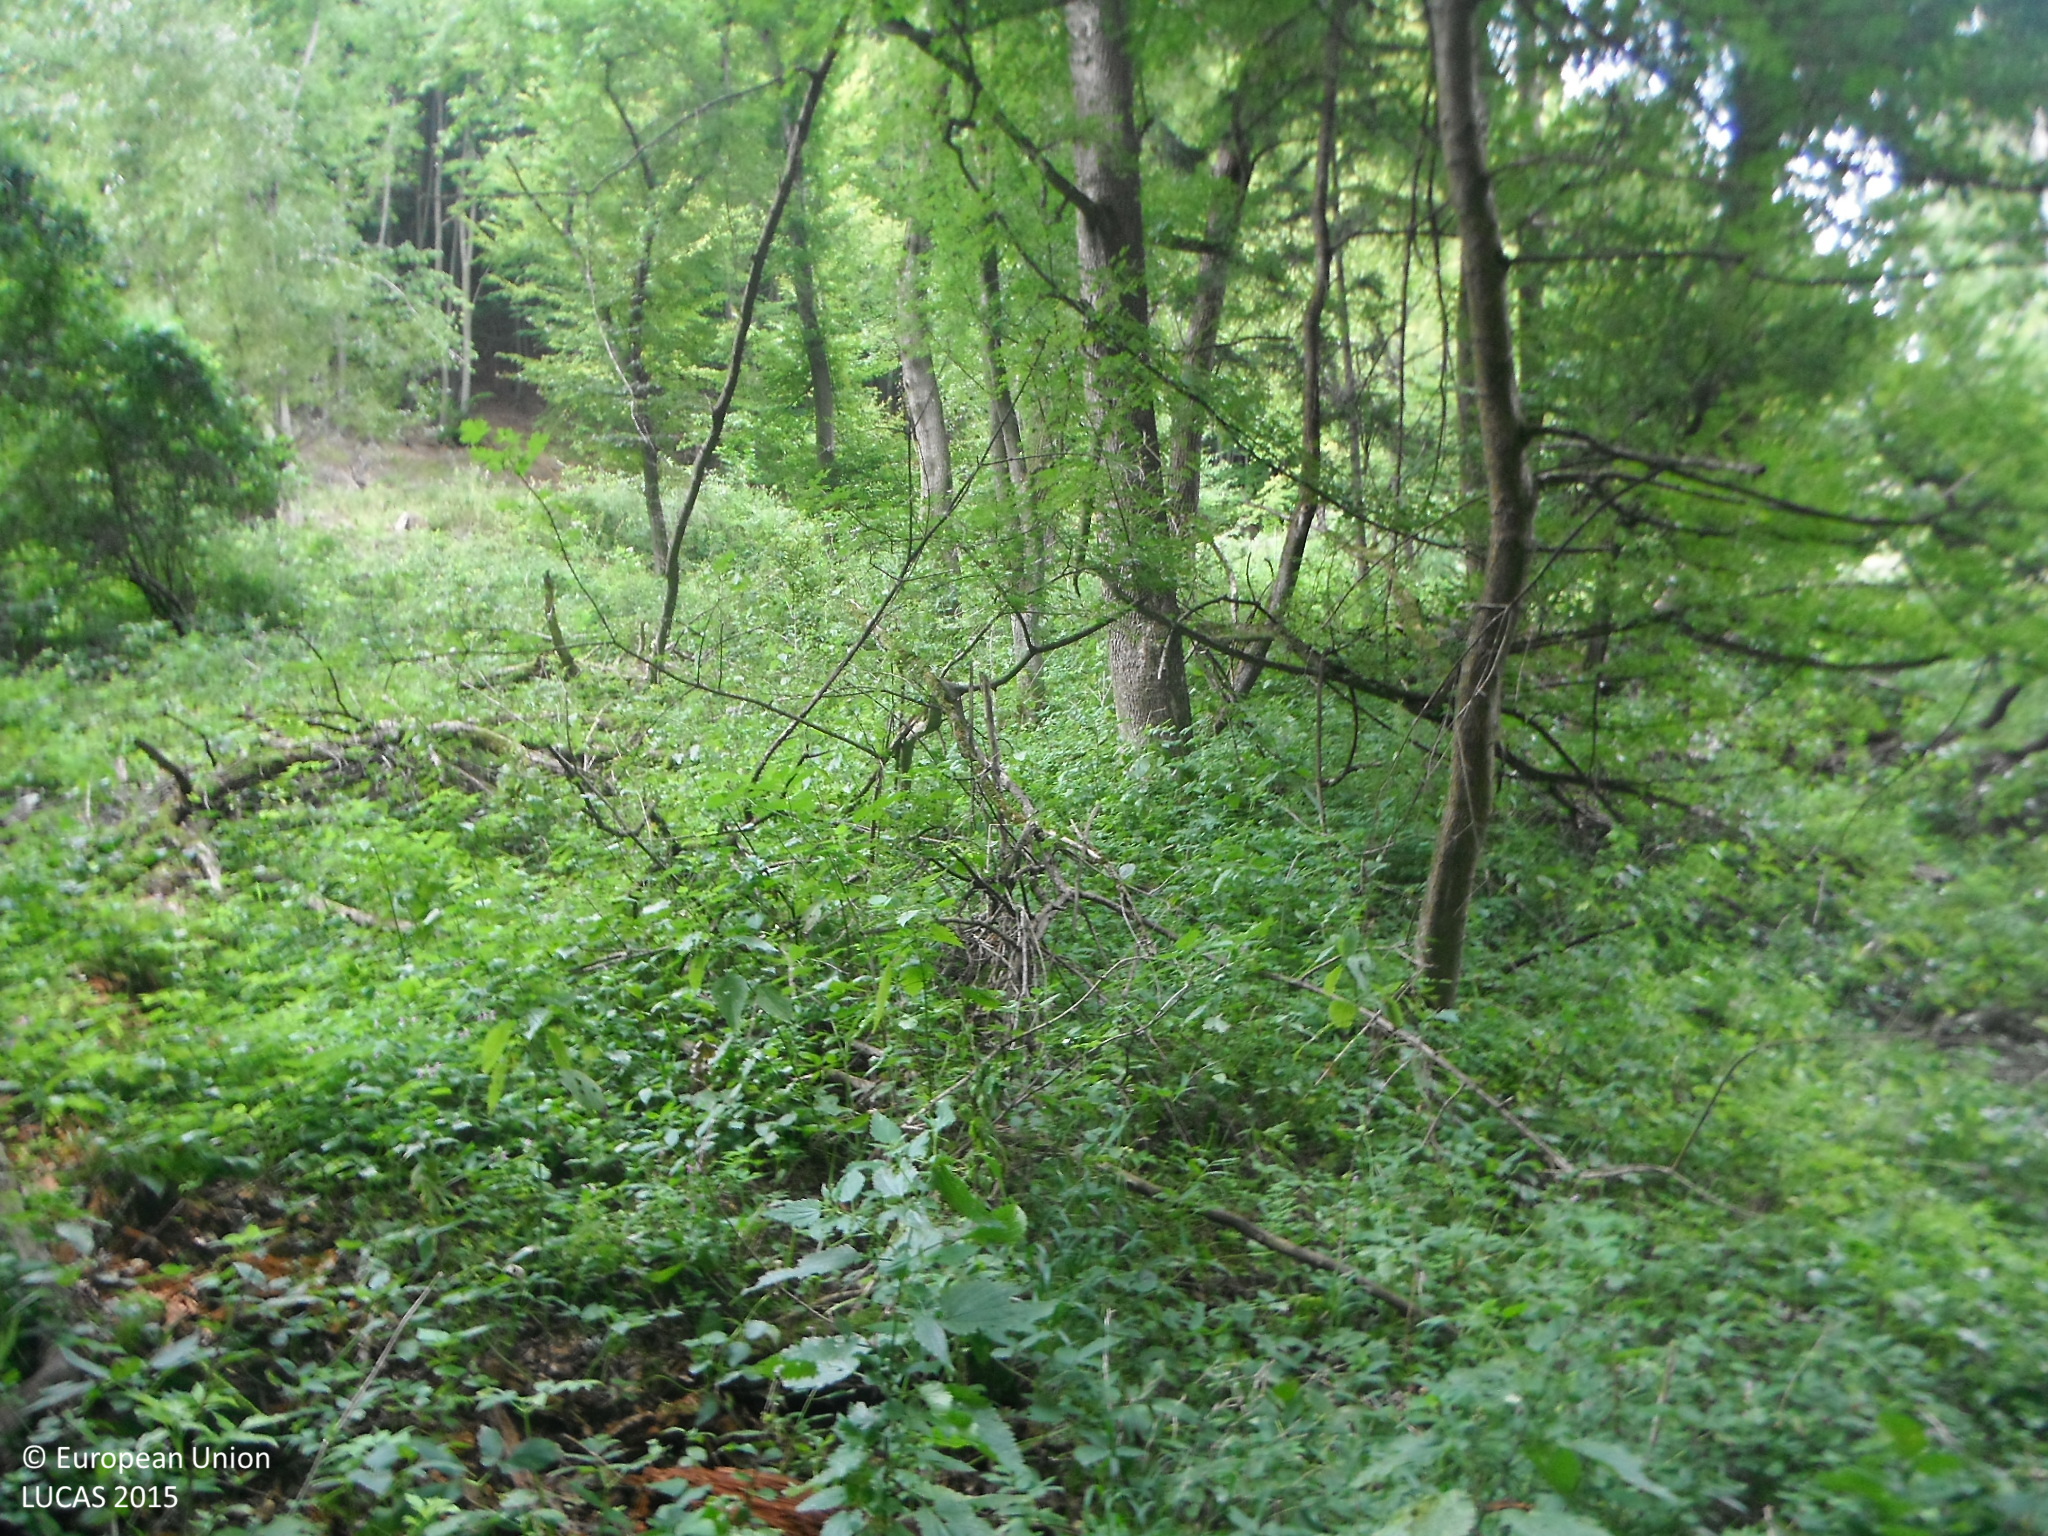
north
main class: Woodland
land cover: Broadleaved woodland
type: beech forest
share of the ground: > 75 %
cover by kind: broadleaved forest trees 85 %, shrubs 10 %, herbaceous plants 5 %
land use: Forestry
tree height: > 5 m
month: September
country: SK
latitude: 48.8774
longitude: 18.1830
